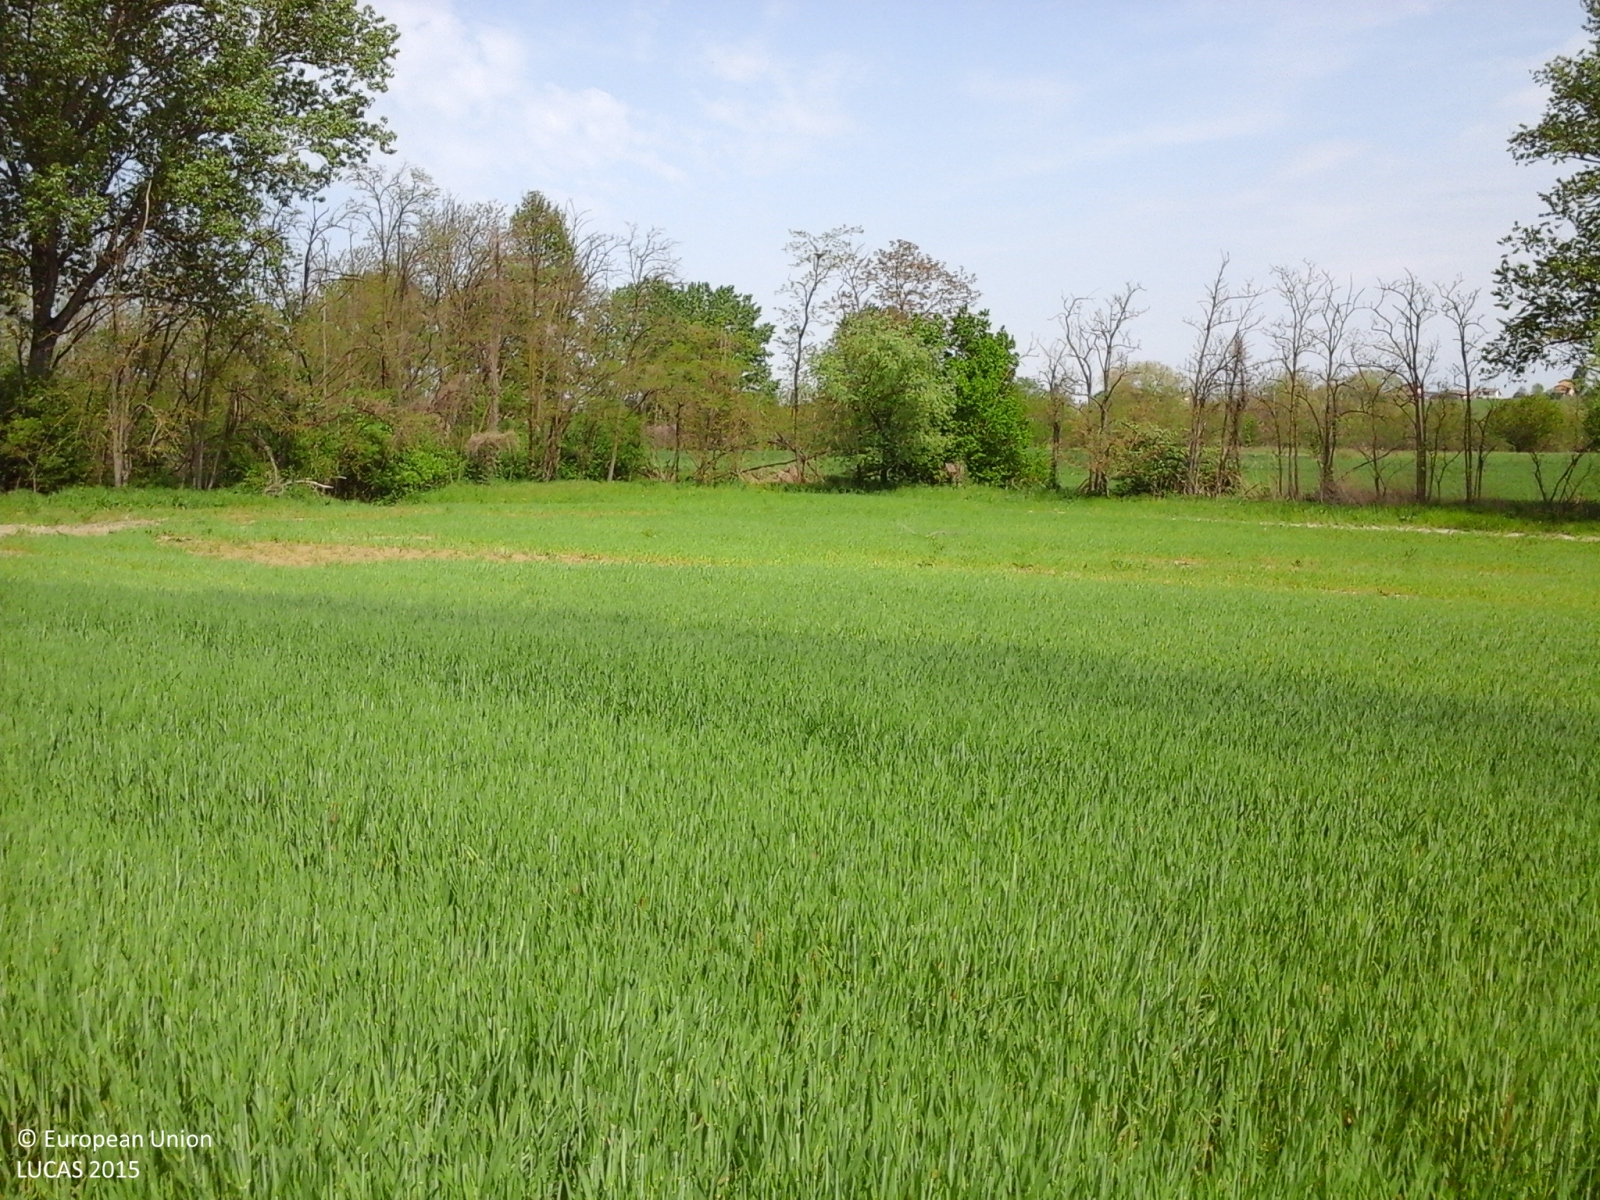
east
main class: Cropland
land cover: Common wheat
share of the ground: > 75 %
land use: Agriculture (excluding fallow land and kitchen gardens)
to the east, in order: Common wheat; Broadleaved woodland; Rivers and streams; Broadleaved woodland; Common wheat; Grass margins; Spontaneously vegetated surfaces; Tracks; Spontaneously vegetated surfaces
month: April
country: IT
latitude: 45.0160
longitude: 9.4048
